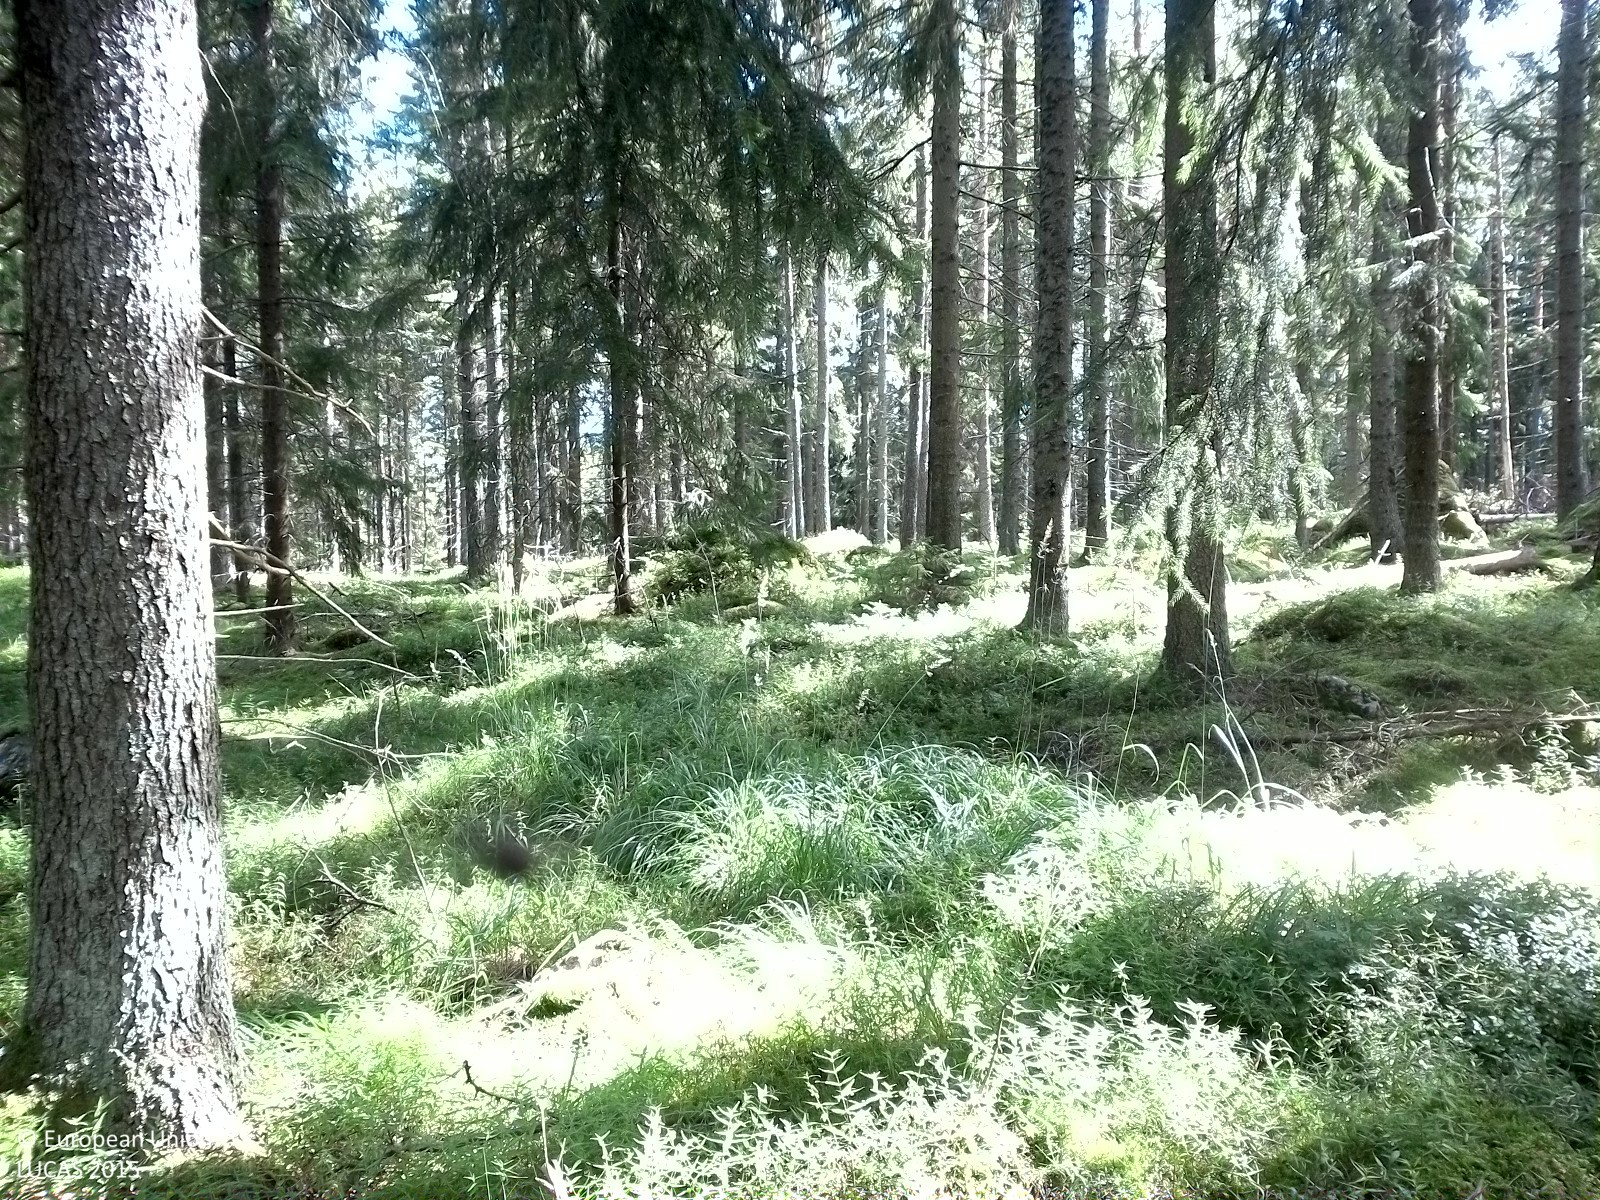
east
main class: Woodland
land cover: Spruce dominated mixed woodland
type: boreal forest
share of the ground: 25 - 50 %
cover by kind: herbaceous plants 35 %, coniferous forest trees 30 %, broadleaved forest trees 15 %, lichens and mosses 15 %, shrubs 5 %
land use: Forestry
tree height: > 5 m
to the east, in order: Spruce dominated mixed woodland; Pine dominated coniferous woodland; Other mixed woodland; Tracks; Other mixed woodland; Pine dominated coniferous woodland; Other mixed woodland; Tracks; Other mixed woodland
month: August
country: SE
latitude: 59.0424
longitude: 15.0989
